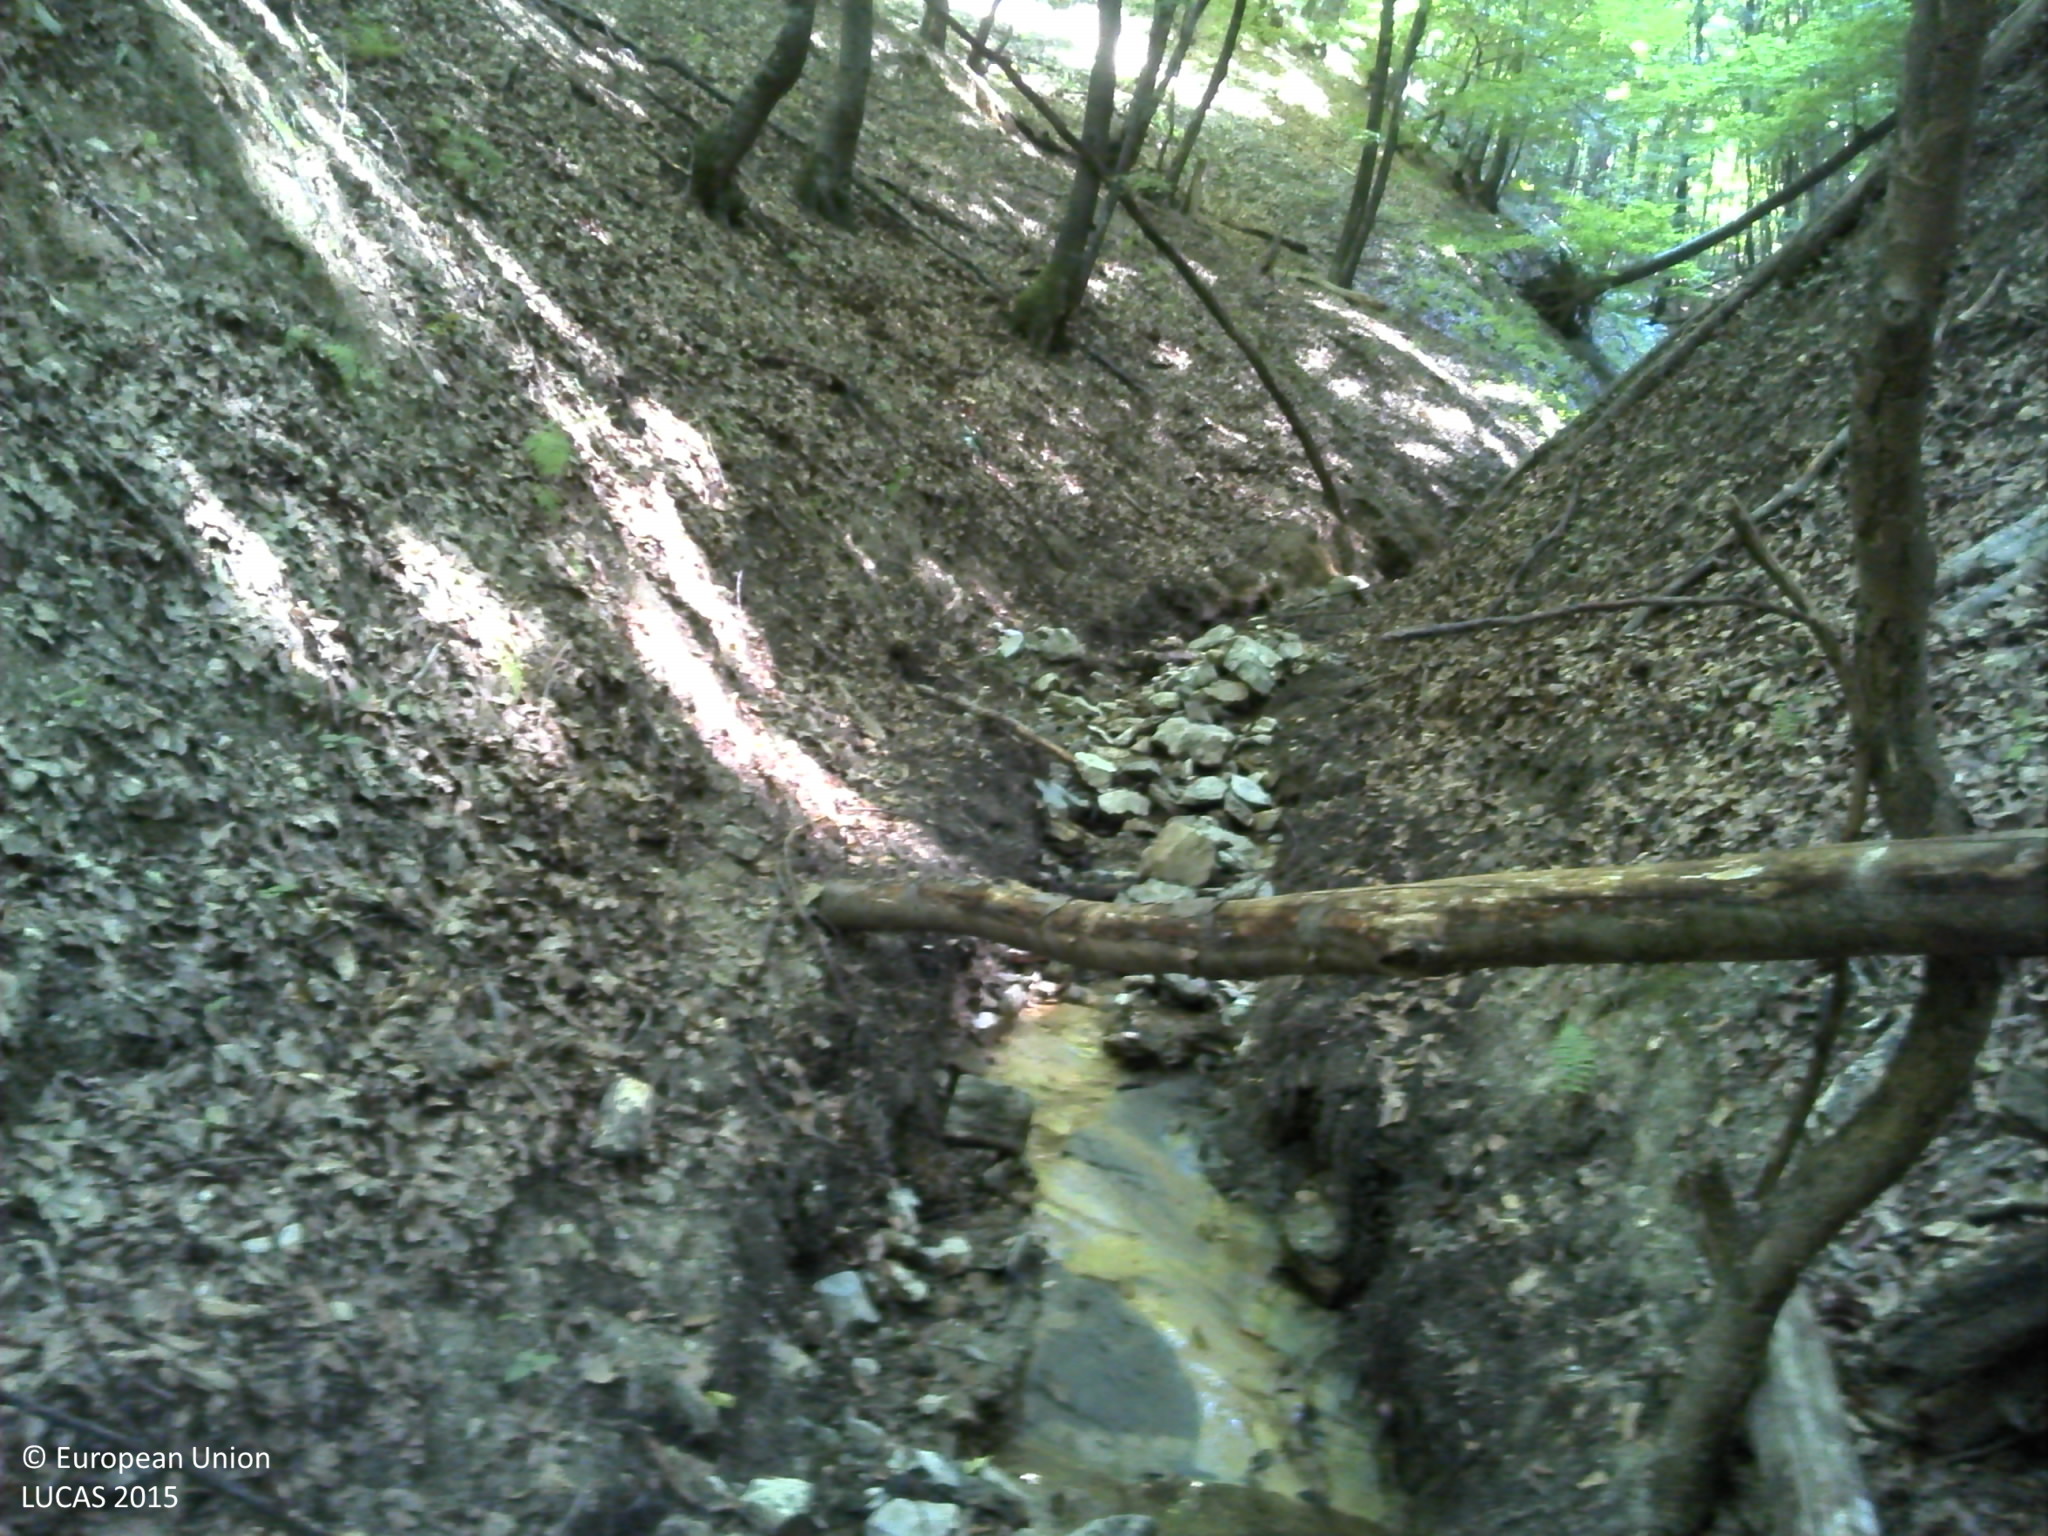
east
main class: Woodland
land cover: Broadleaved woodland
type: beech forest
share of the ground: > 75 %
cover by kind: broadleaved forest trees 100 %
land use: Forestry
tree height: > 5 m
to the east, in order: Broadleaved woodland; Ditches and canals; Broadleaved woodland
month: August
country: HR
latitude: 45.3034
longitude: 17.5894
